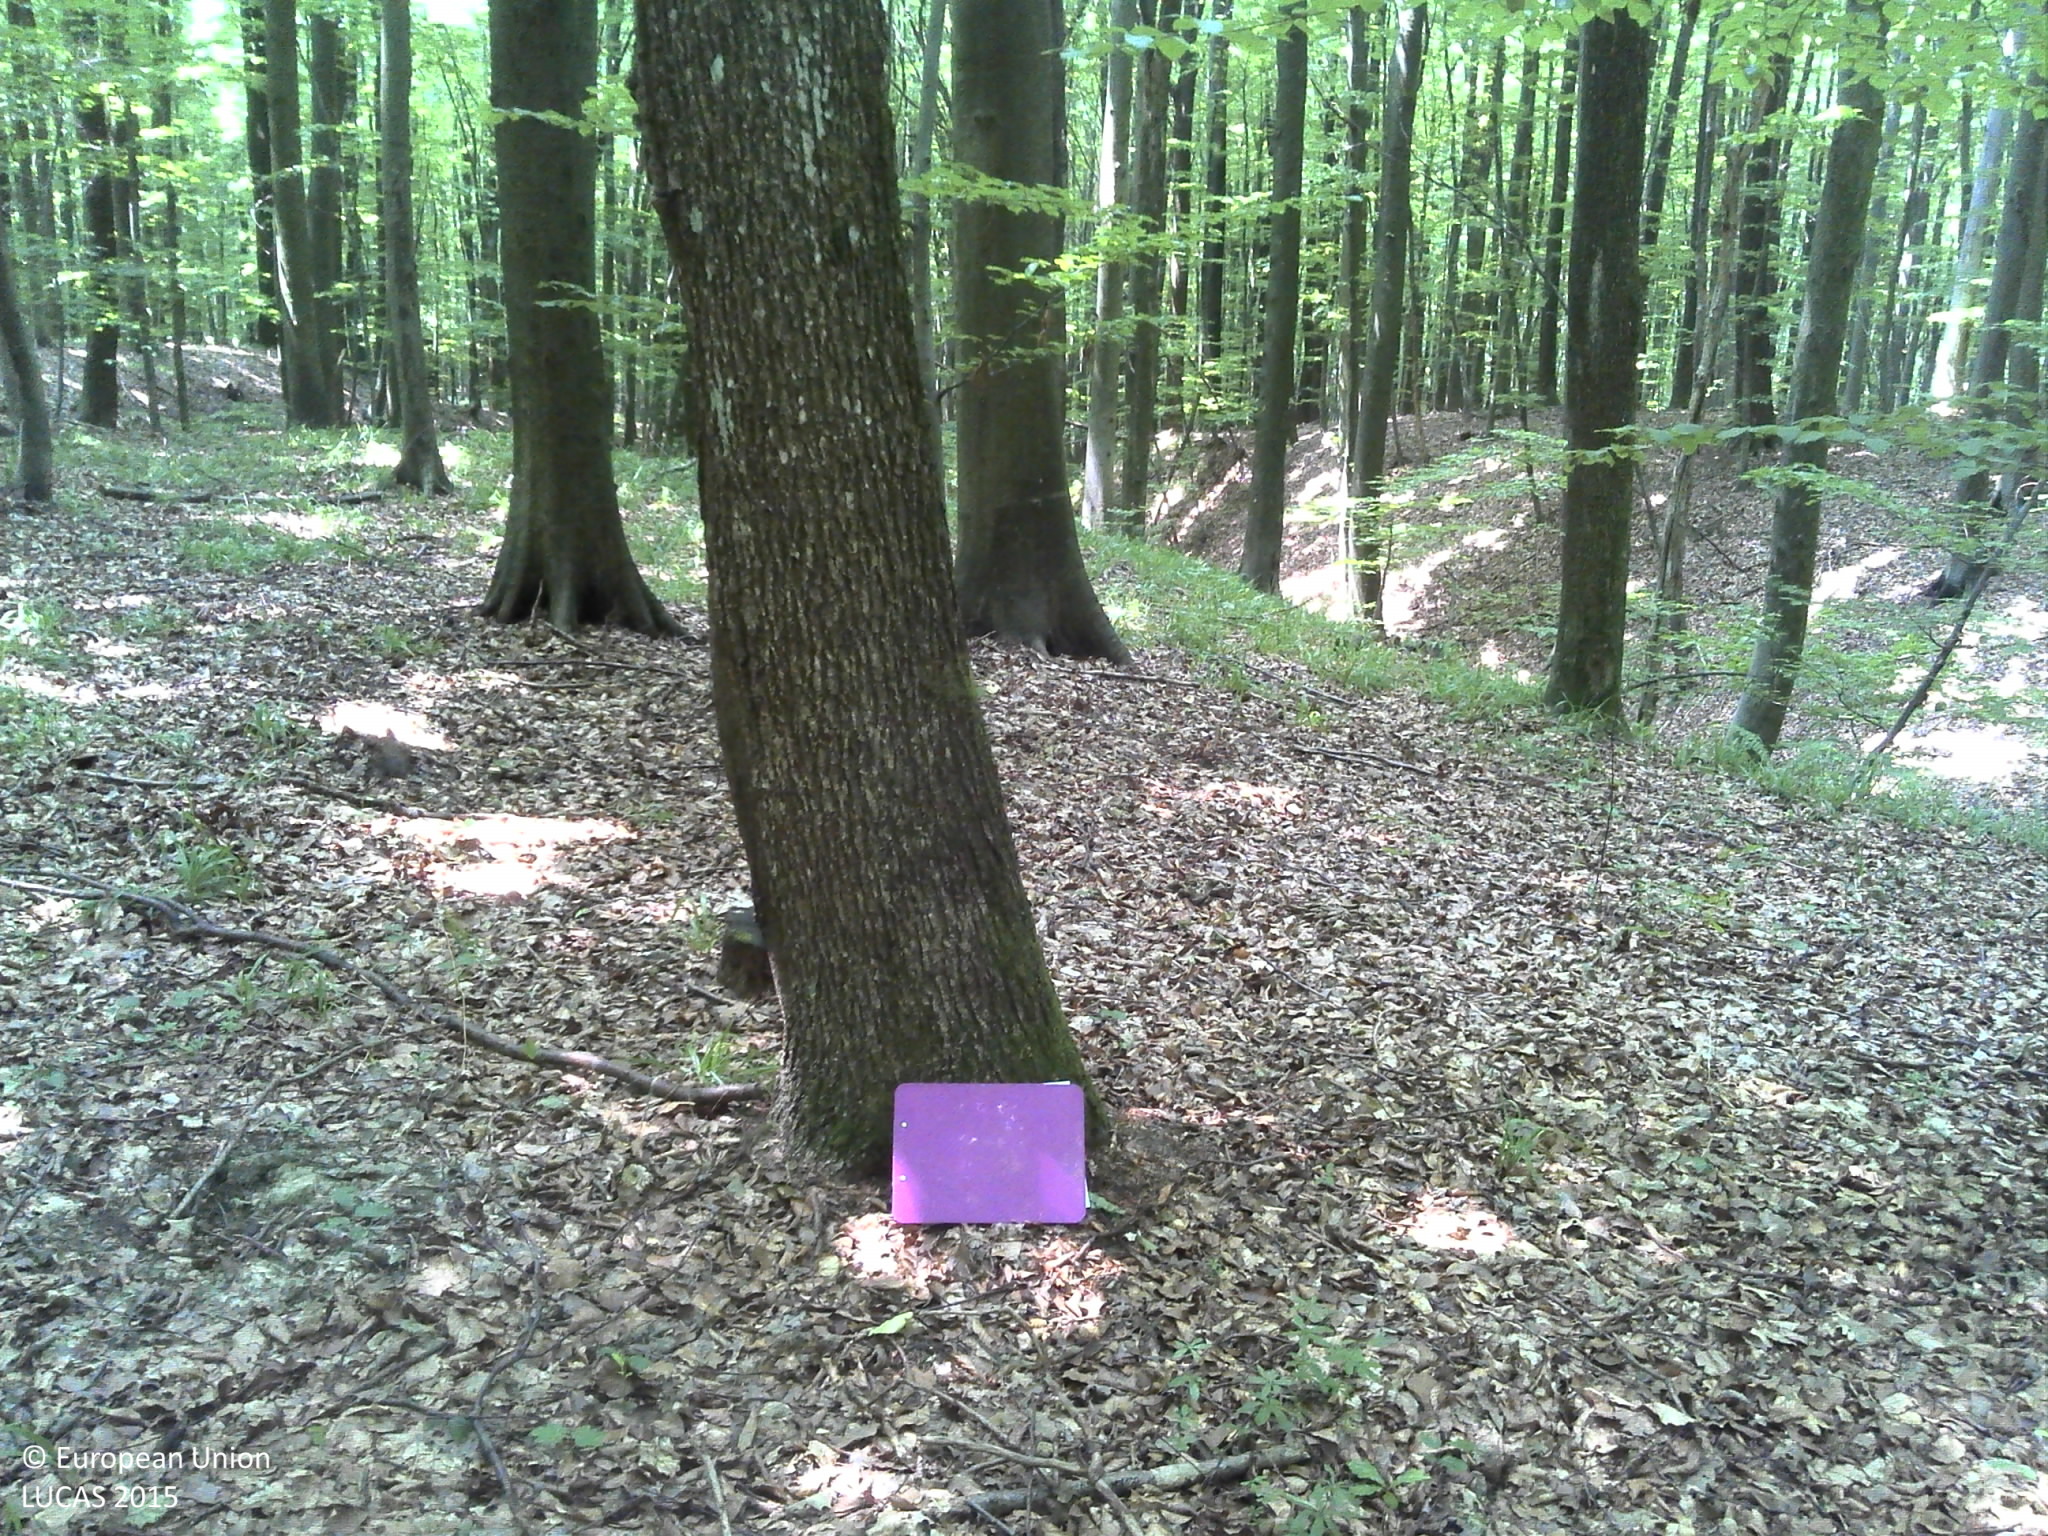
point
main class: Woodland
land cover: Broadleaved woodland
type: acidophilous oak and oak-birch forest
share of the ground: > 75 %
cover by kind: broadleaved forest trees 95 %, herbaceous plants 5 %
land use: Forestry
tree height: > 5 m
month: July
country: HR
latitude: 46.0762
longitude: 16.8670
